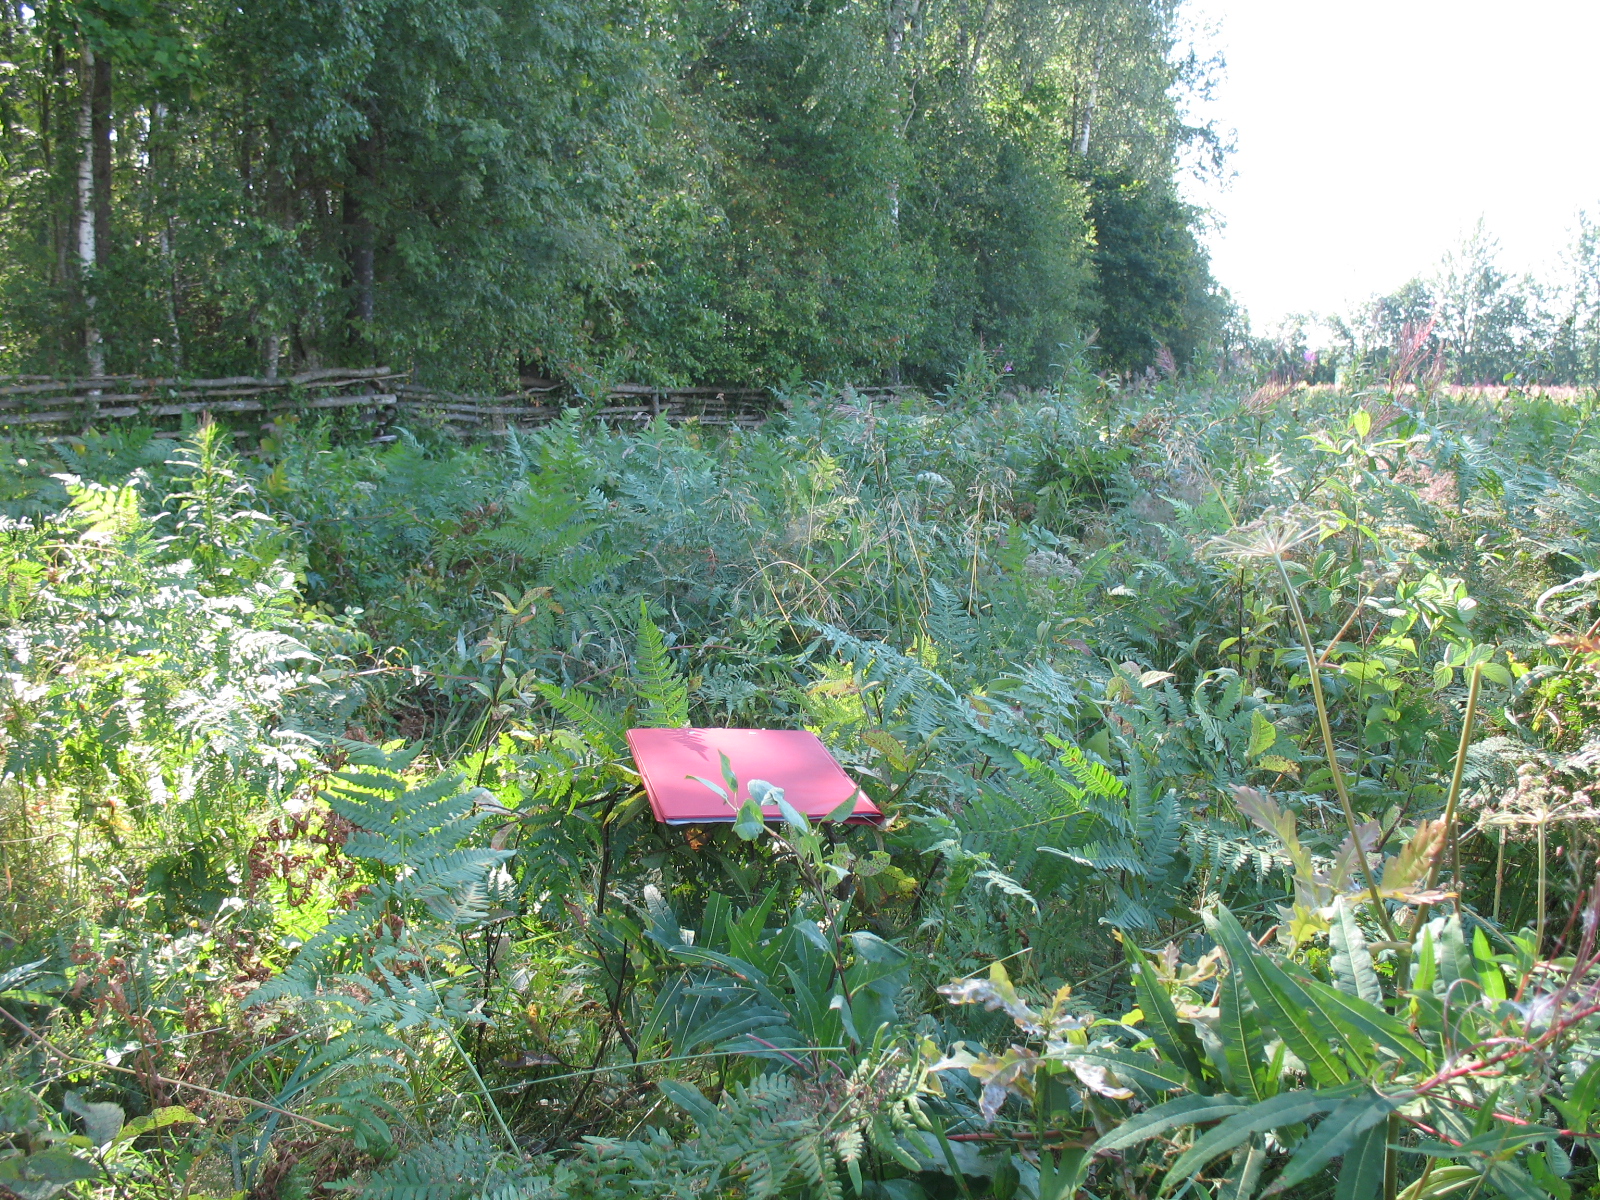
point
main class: Grassland
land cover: Spontaneously vegetated surfaces
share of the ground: > 75 %
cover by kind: herbaceous plants 100 %
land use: Agriculture (excluding fallow land and kitchen gardens)
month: August
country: LV
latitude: 56.5513
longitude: 25.2586
